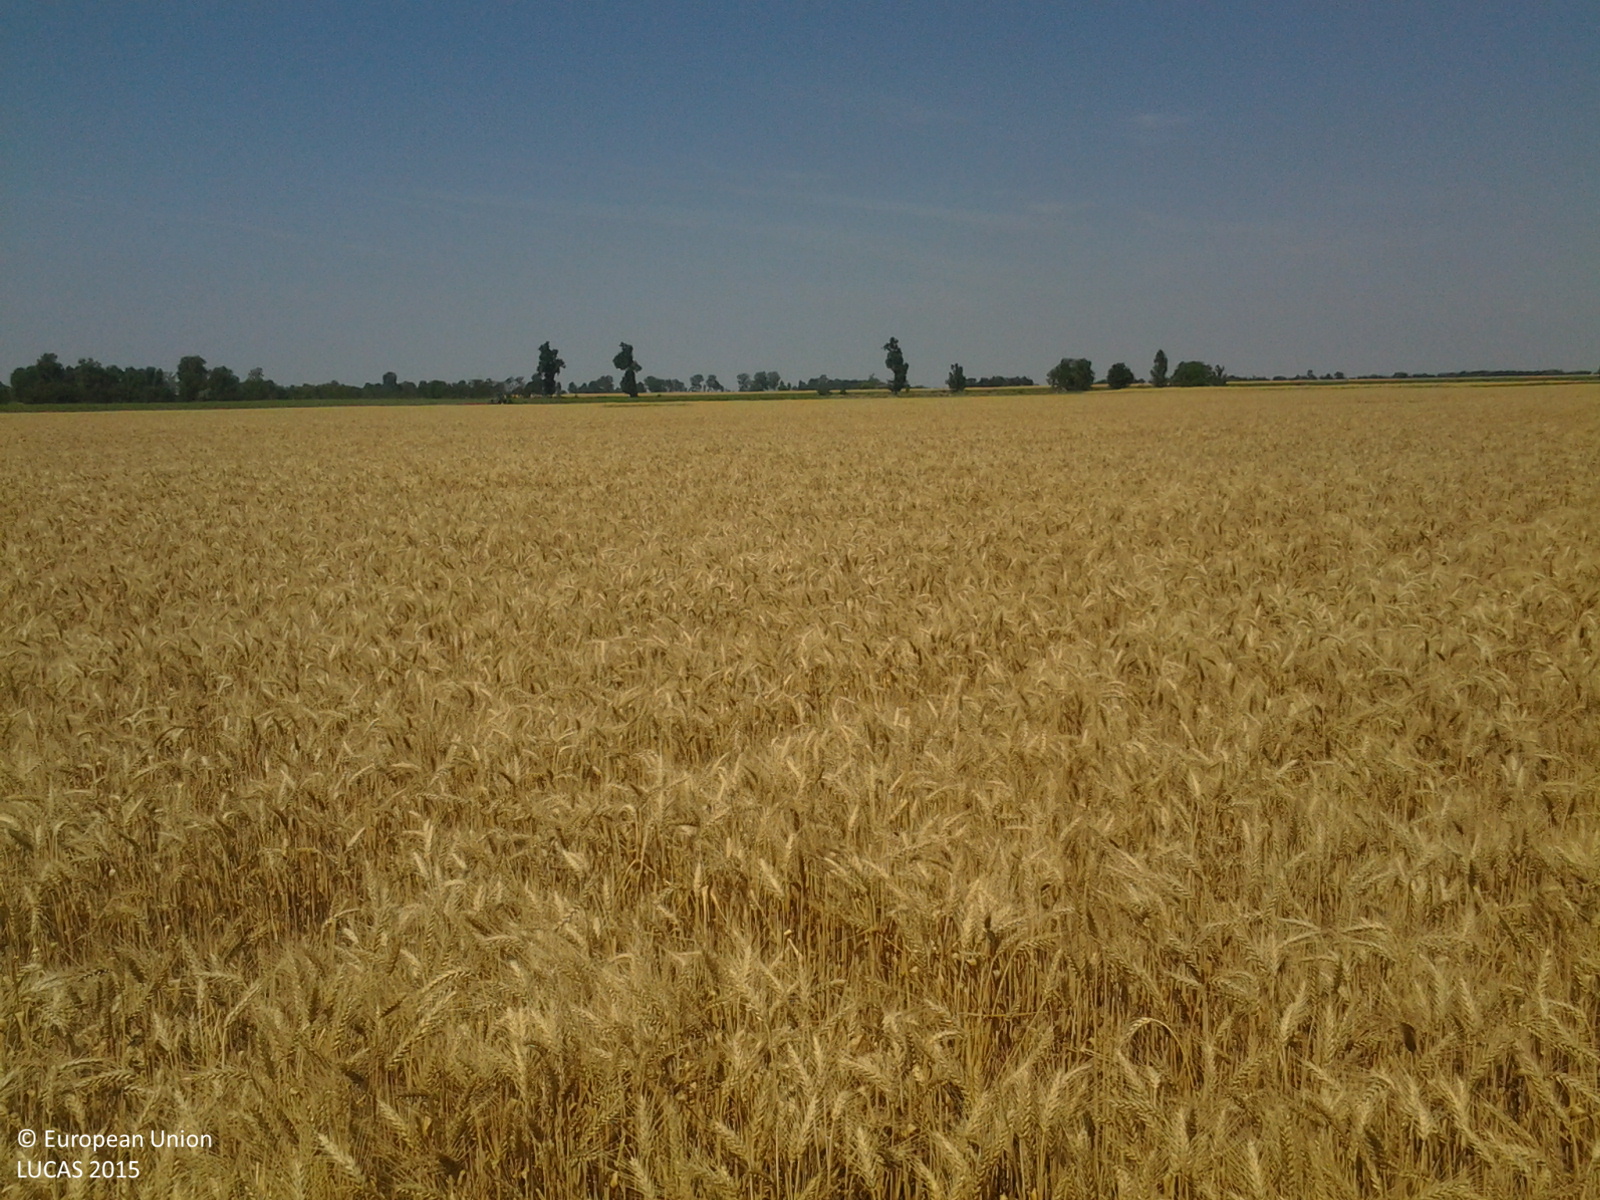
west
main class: Cropland
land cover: Common wheat
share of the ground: > 75 %
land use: Agriculture (excluding fallow land and kitchen gardens)
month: July
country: HU
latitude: 46.8312
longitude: 20.5030
